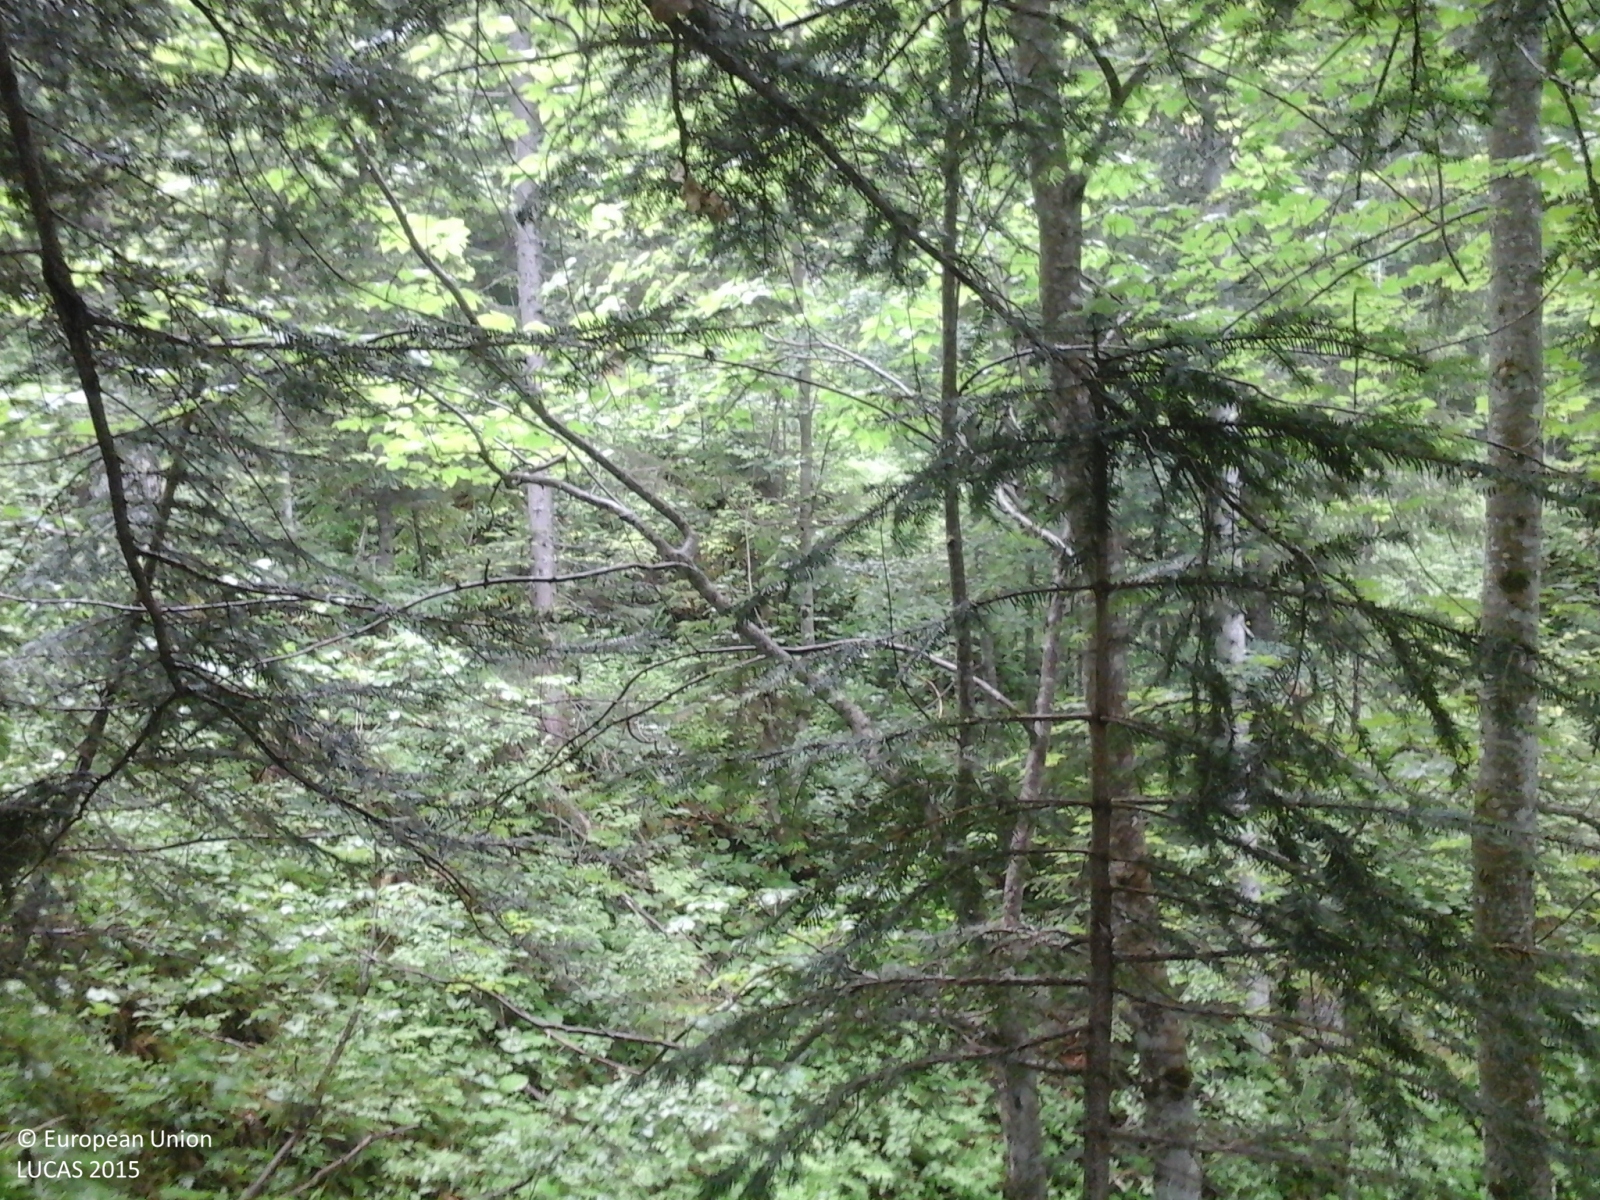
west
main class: Woodland
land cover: Other coniferous woodland
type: alpine coniferous forest
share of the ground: > 75 %
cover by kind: coniferous forest trees 100 %
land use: Forestry
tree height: > 5 m
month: June
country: IT
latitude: 46.5745
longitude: 12.4896
